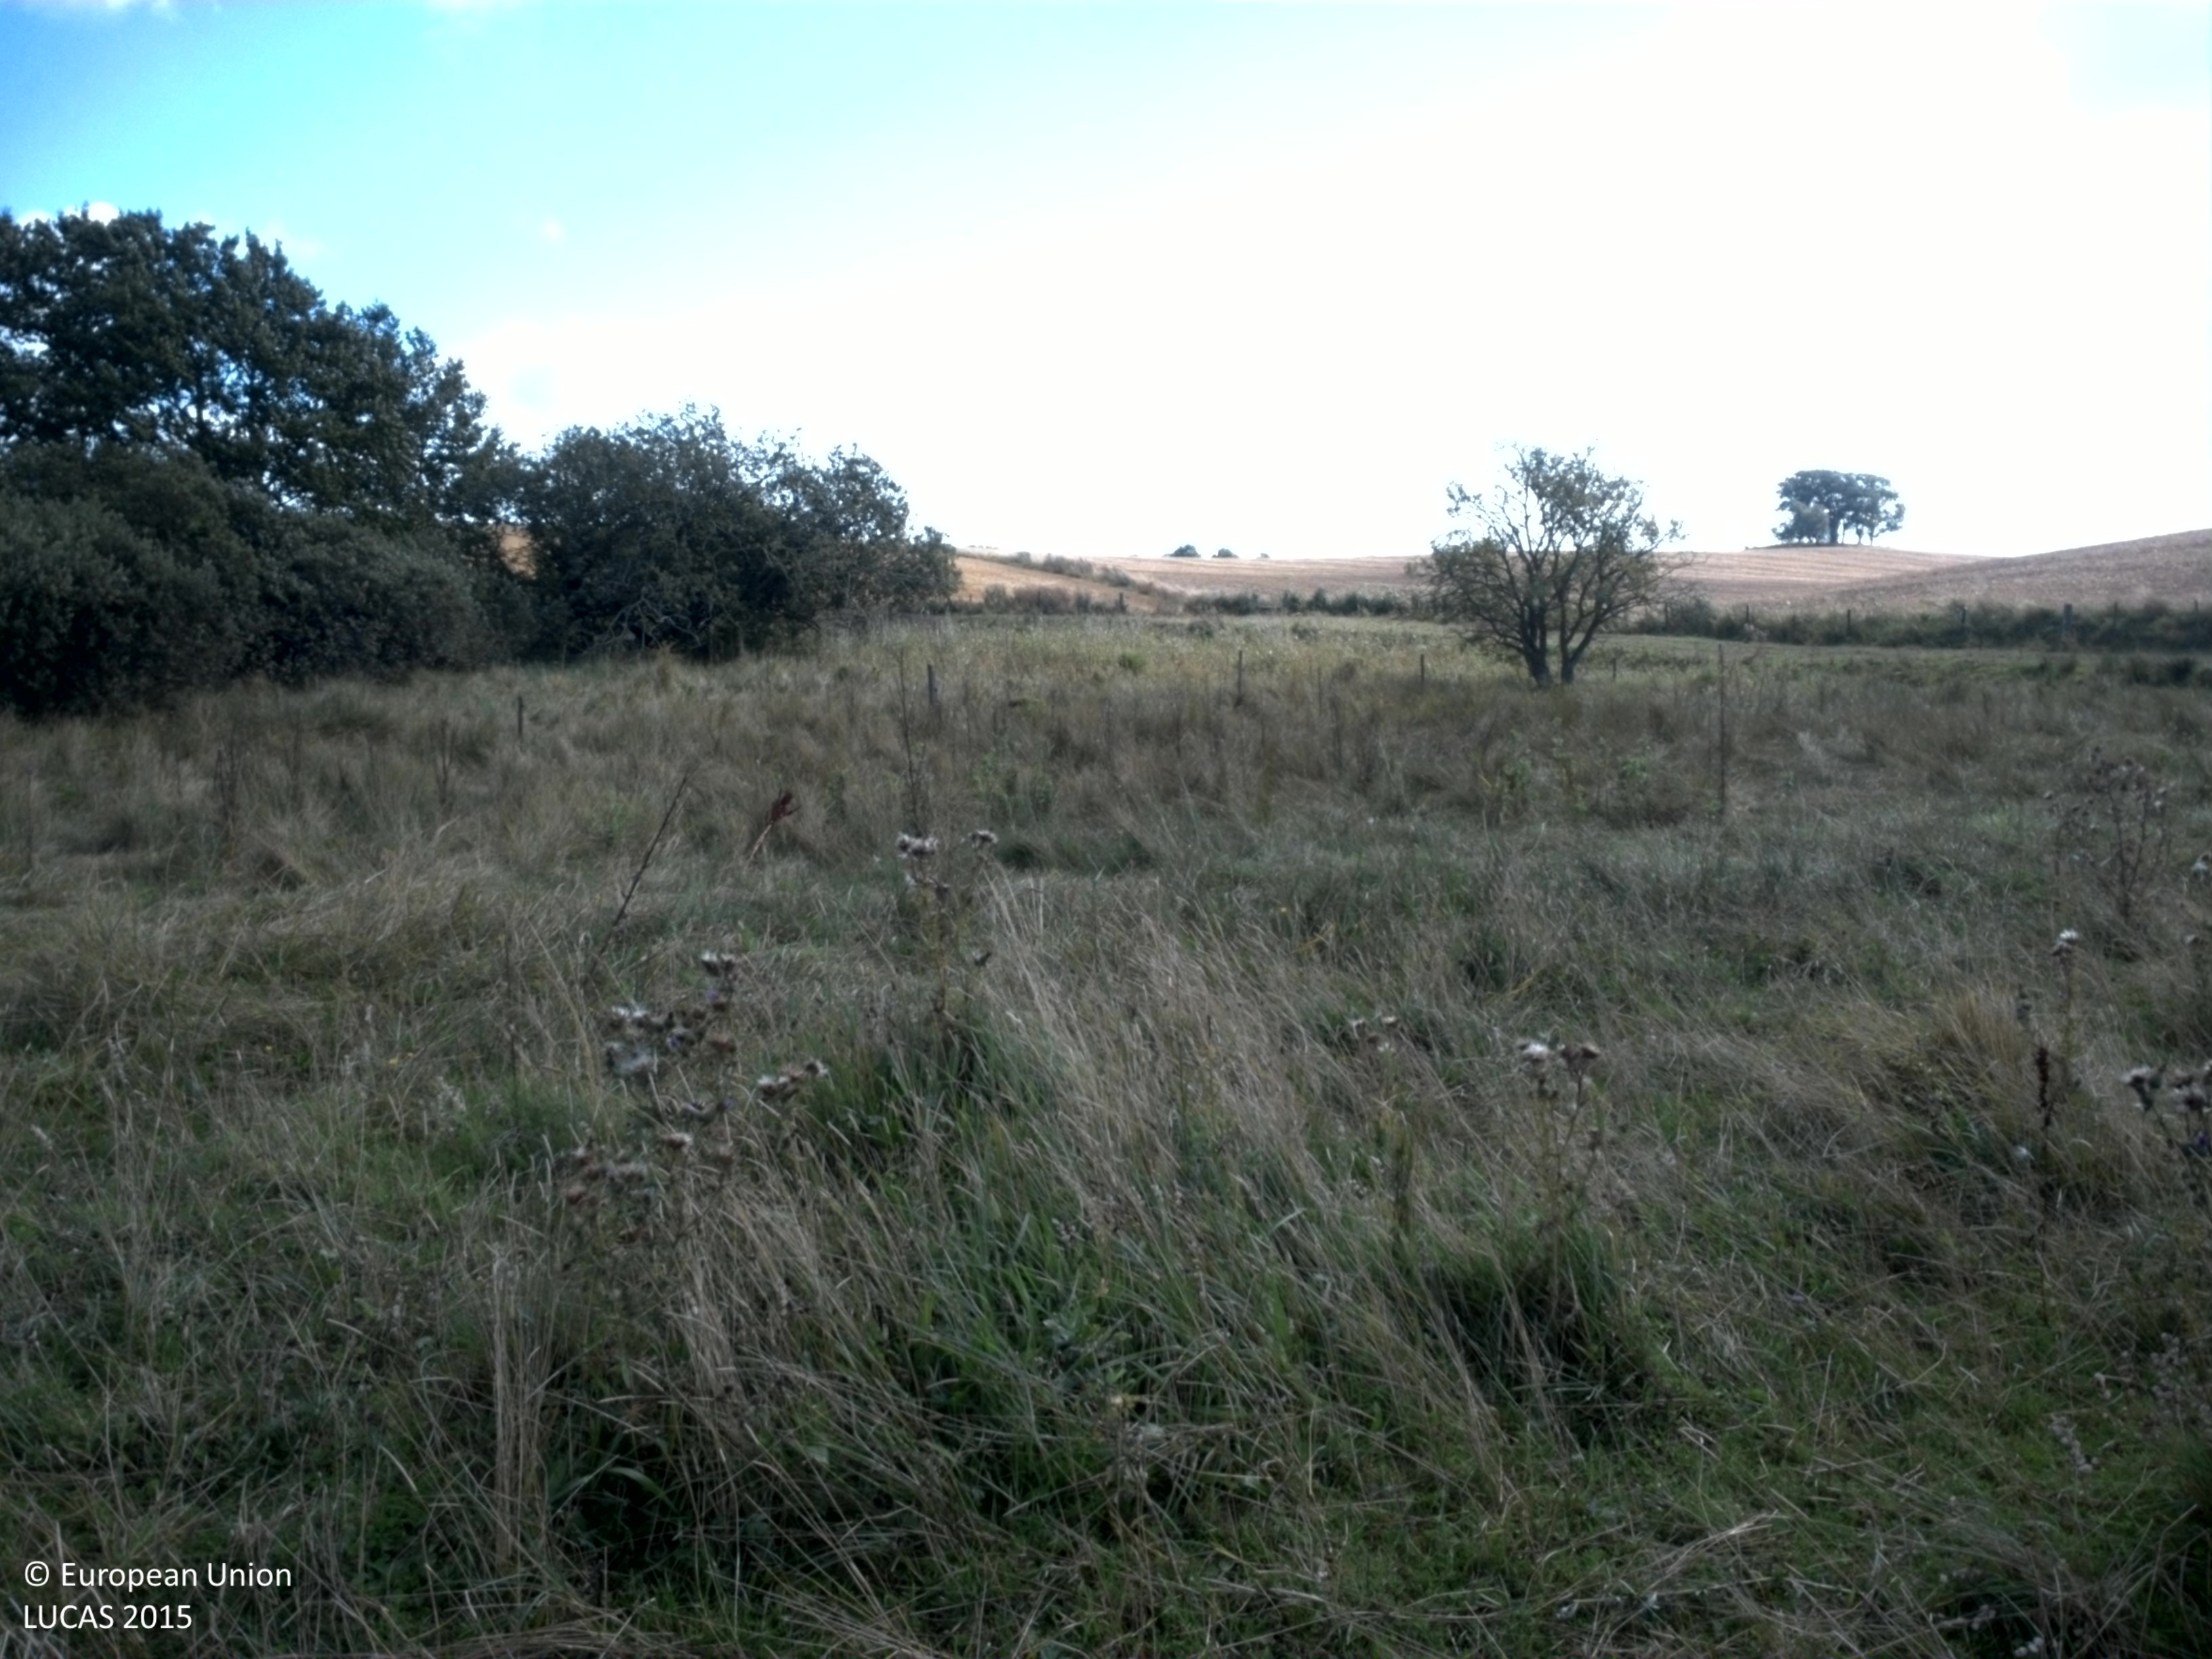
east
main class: Grassland
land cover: Grassland without tree/shrub cover
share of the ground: > 75 %
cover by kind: herbaceous plants 90 %, shrubs 5 %, unconsolidated bare surface 5 %
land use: Agriculture (excluding fallow land and kitchen gardens)
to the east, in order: Grassland without tree/shrub cover; Broadleaved woodland; Inland fresh water bodies; Grassland without tree/shrub cover; Fences; Common wheat
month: September
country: SE
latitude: 55.5230
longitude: 14.2597
